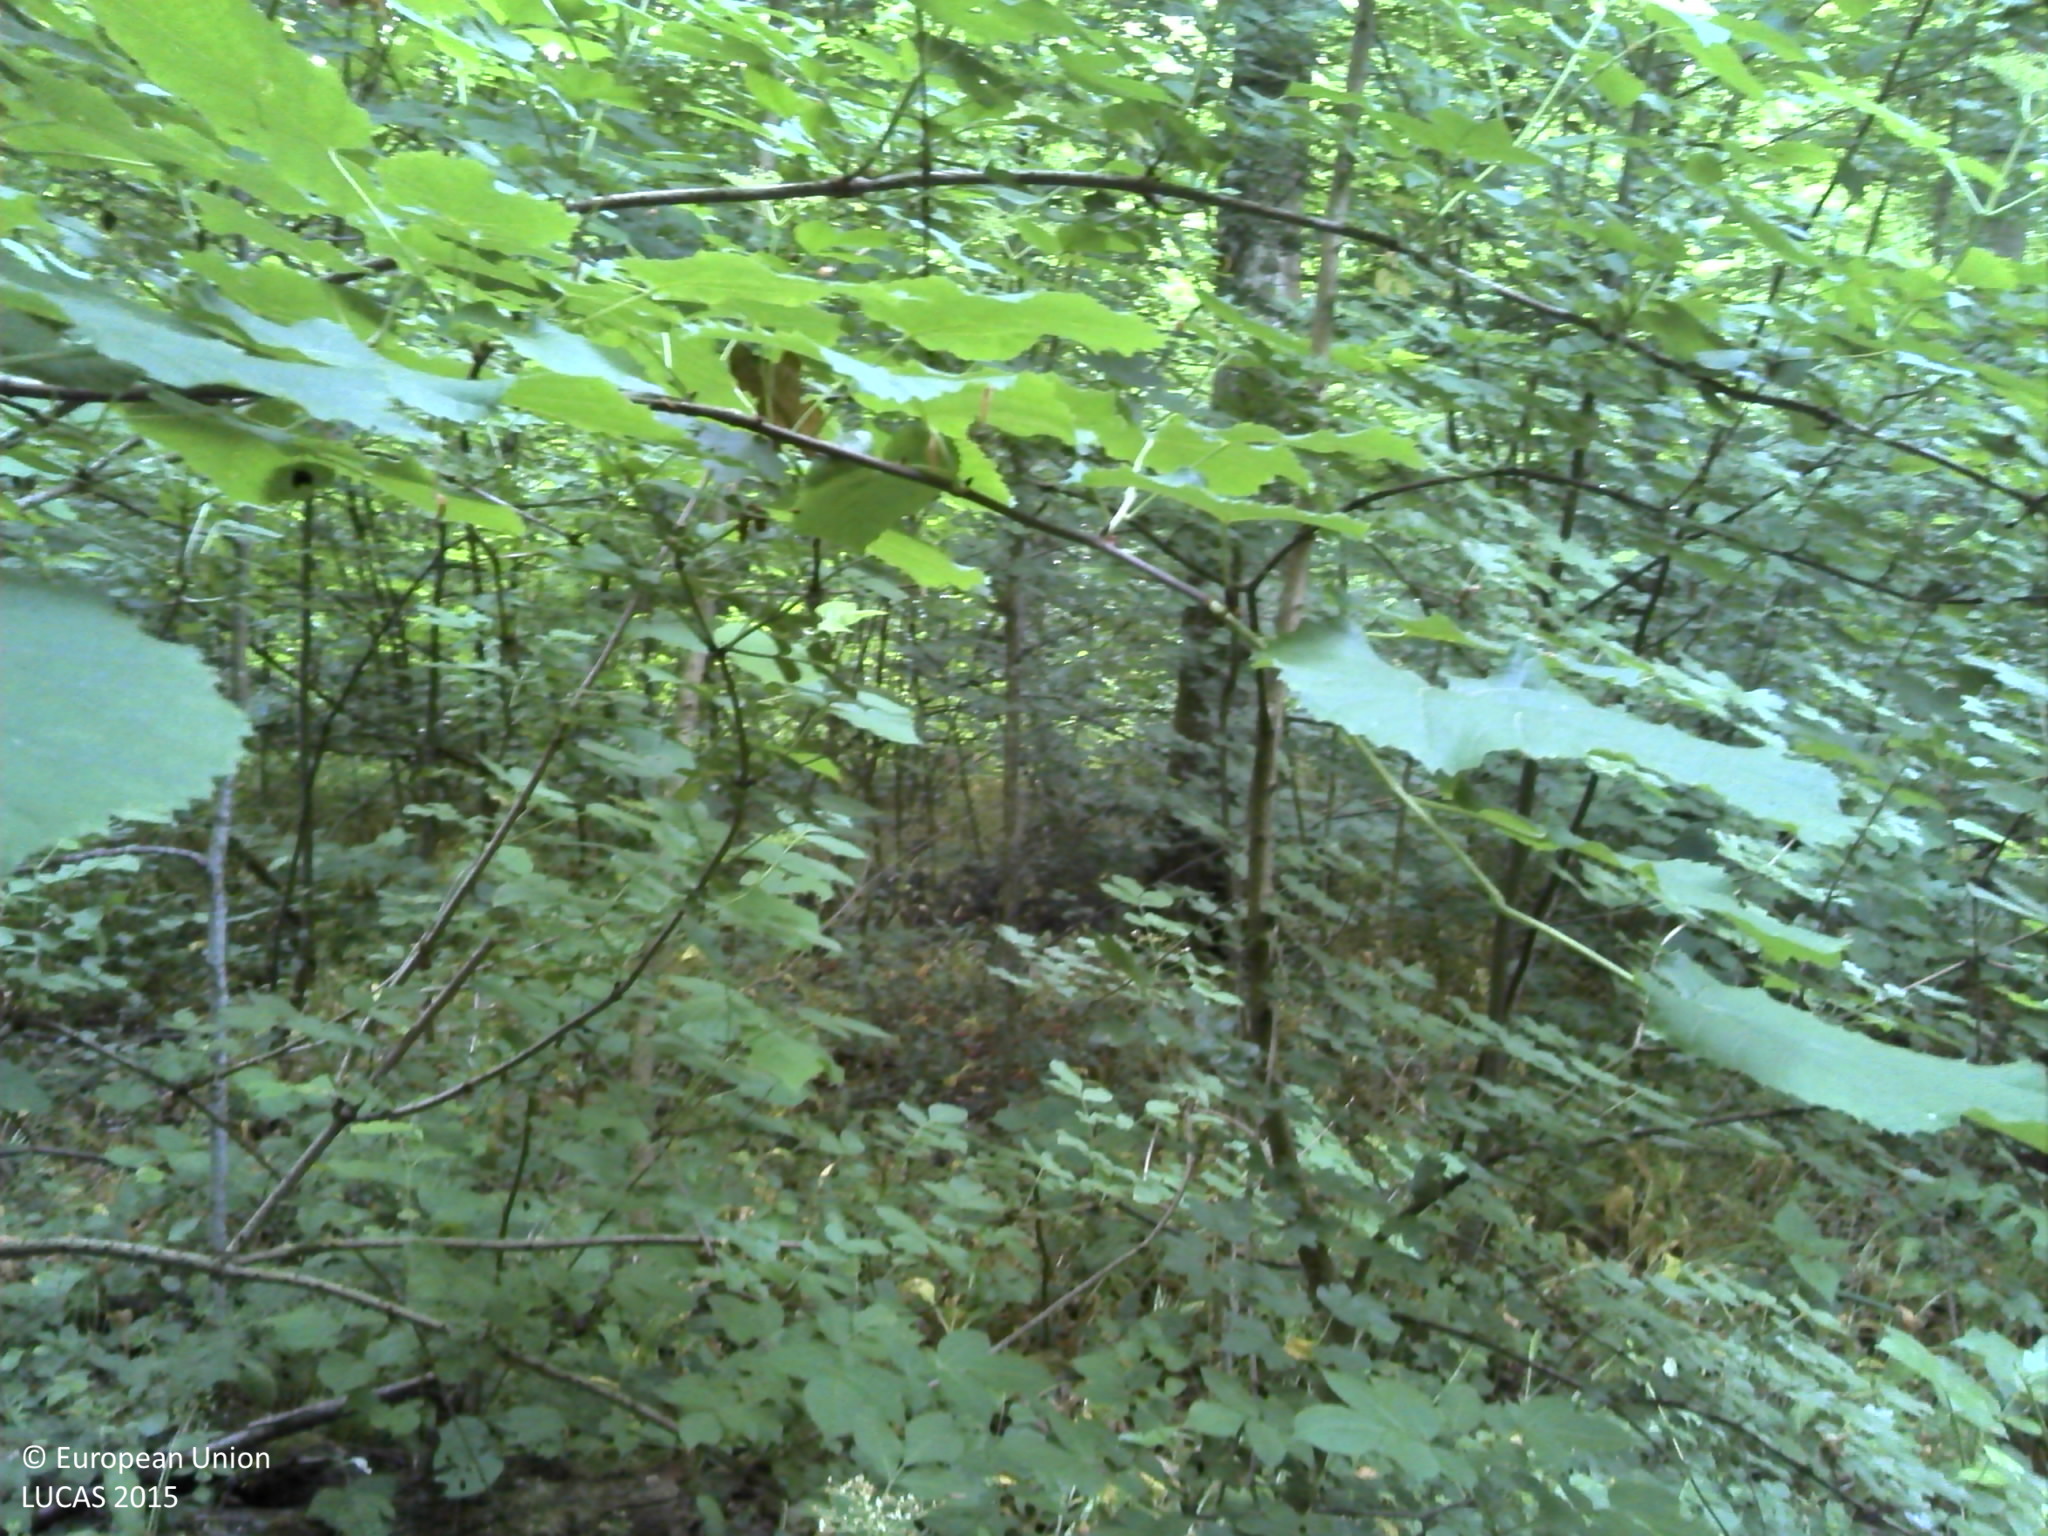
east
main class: Woodland
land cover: Broadleaved woodland
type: acidophilous oak and oak-birch forest
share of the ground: > 75 %
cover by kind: broadleaved forest trees 100 %
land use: Forestry
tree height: > 5 m
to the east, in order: Broadleaved woodland; Ditches and canals; Spontaneously vegetated surfaces; Maize
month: May
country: HR
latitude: 45.5619
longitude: 18.2431
